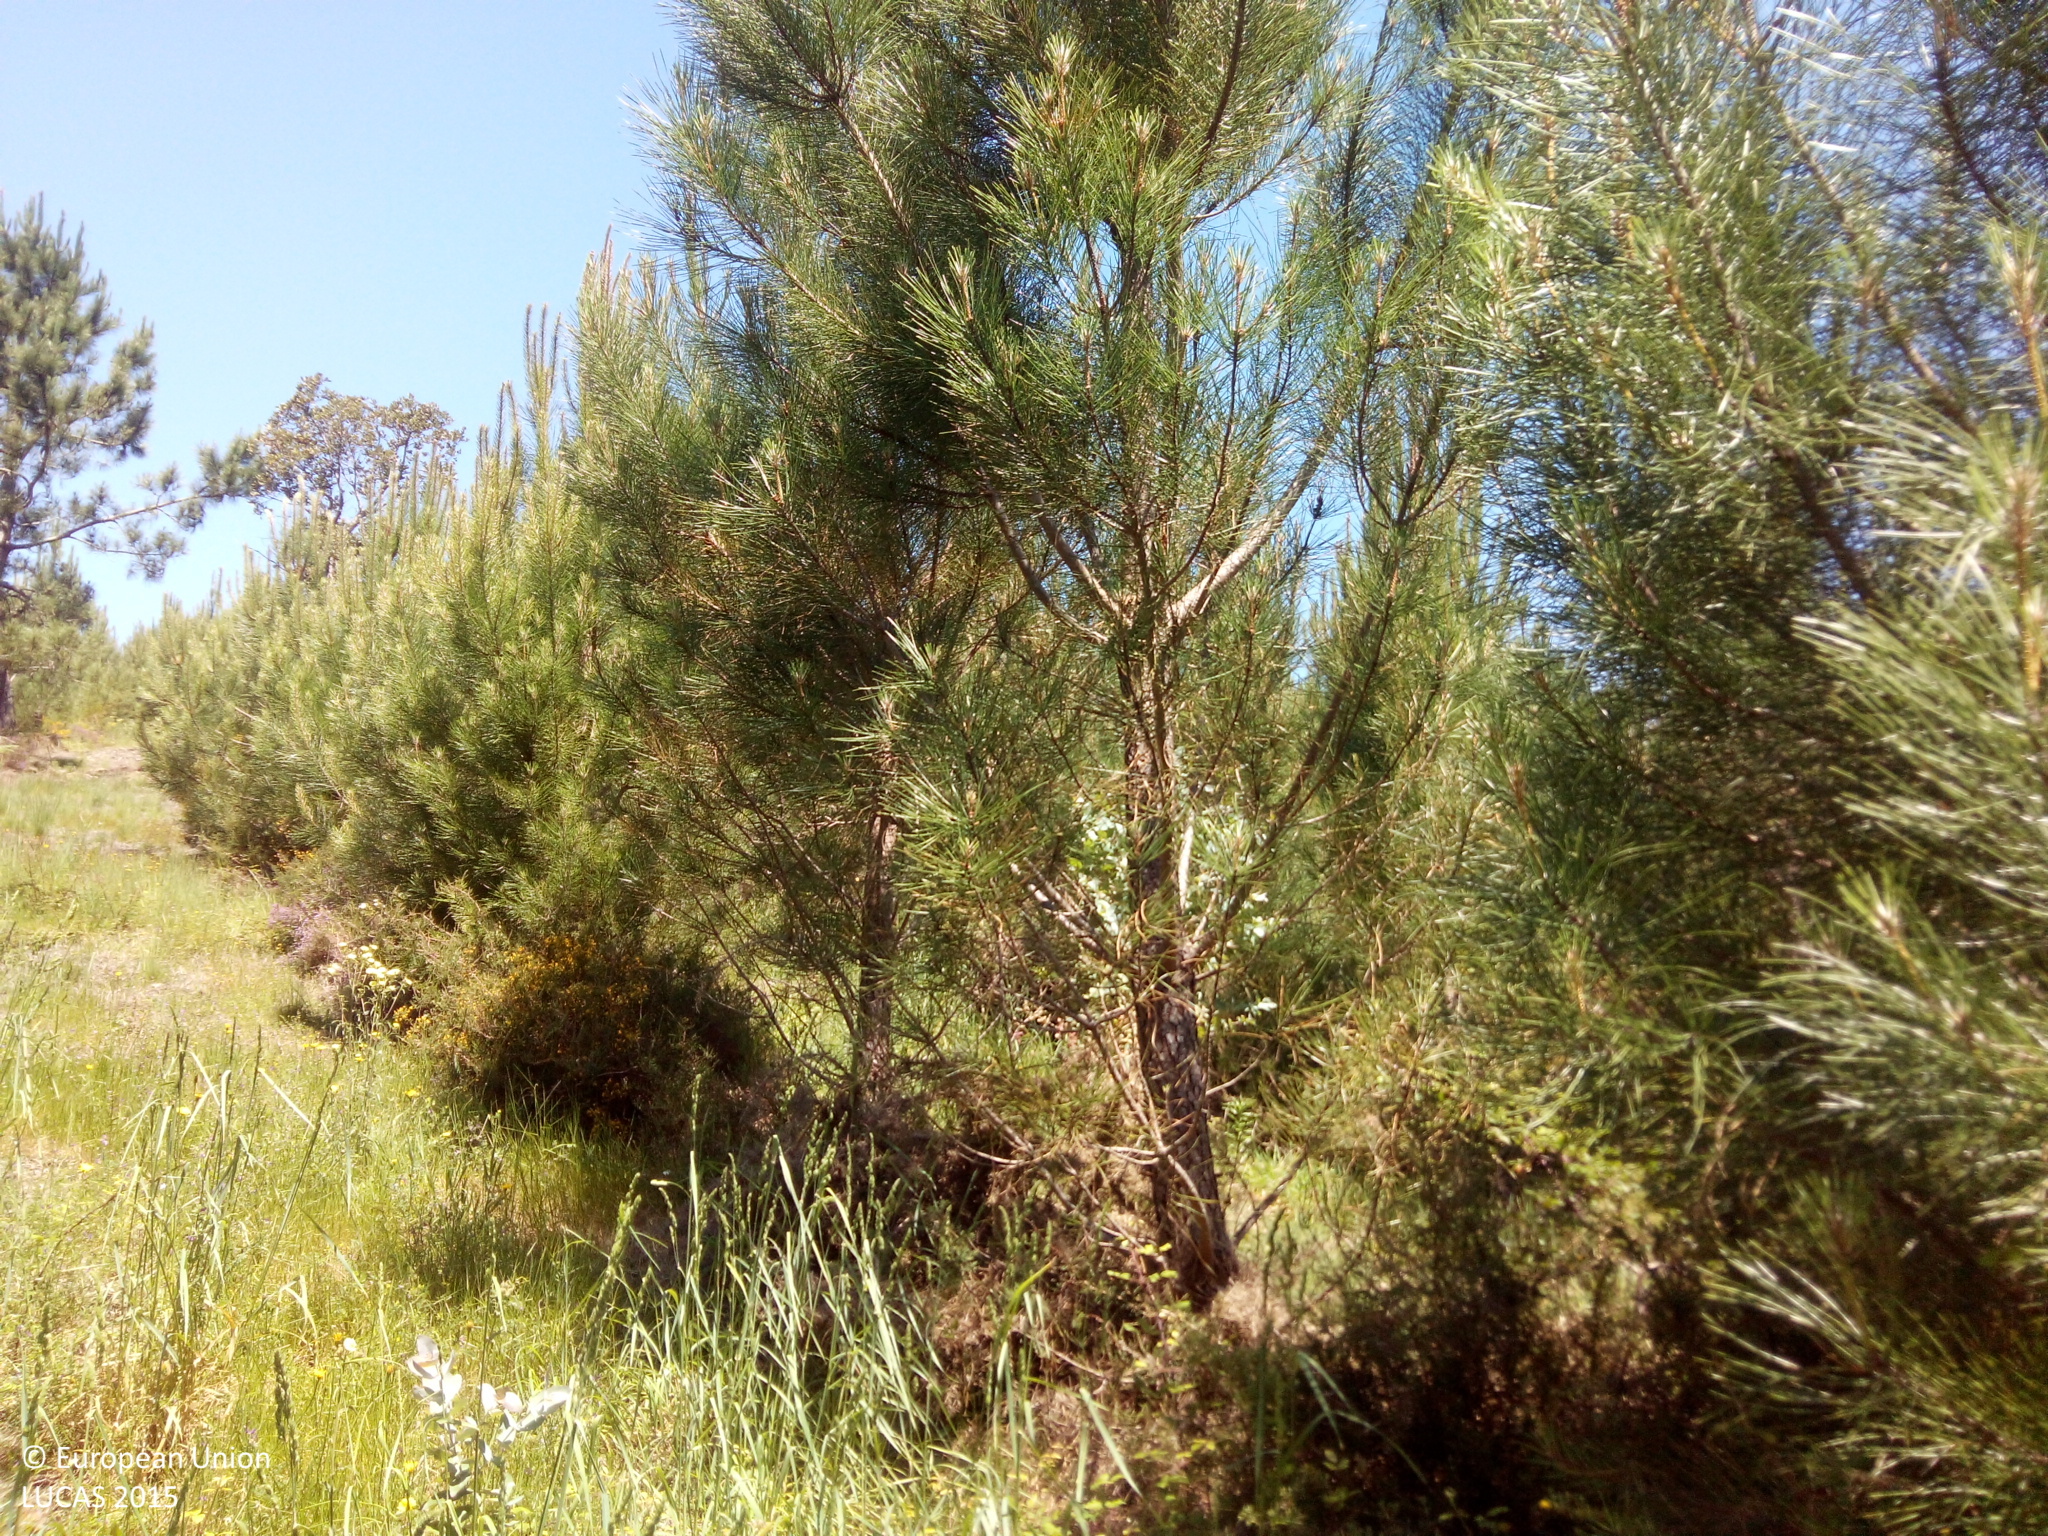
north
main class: Woodland
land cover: Pine dominated coniferous woodland
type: exotic forest
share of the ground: > 75 %
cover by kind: coniferous forest trees 70 %, shrubs 20 %, herbaceous plants 10 %
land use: Forestry
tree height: > 5 m
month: May
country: ES
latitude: 42.6470
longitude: -9.0099
